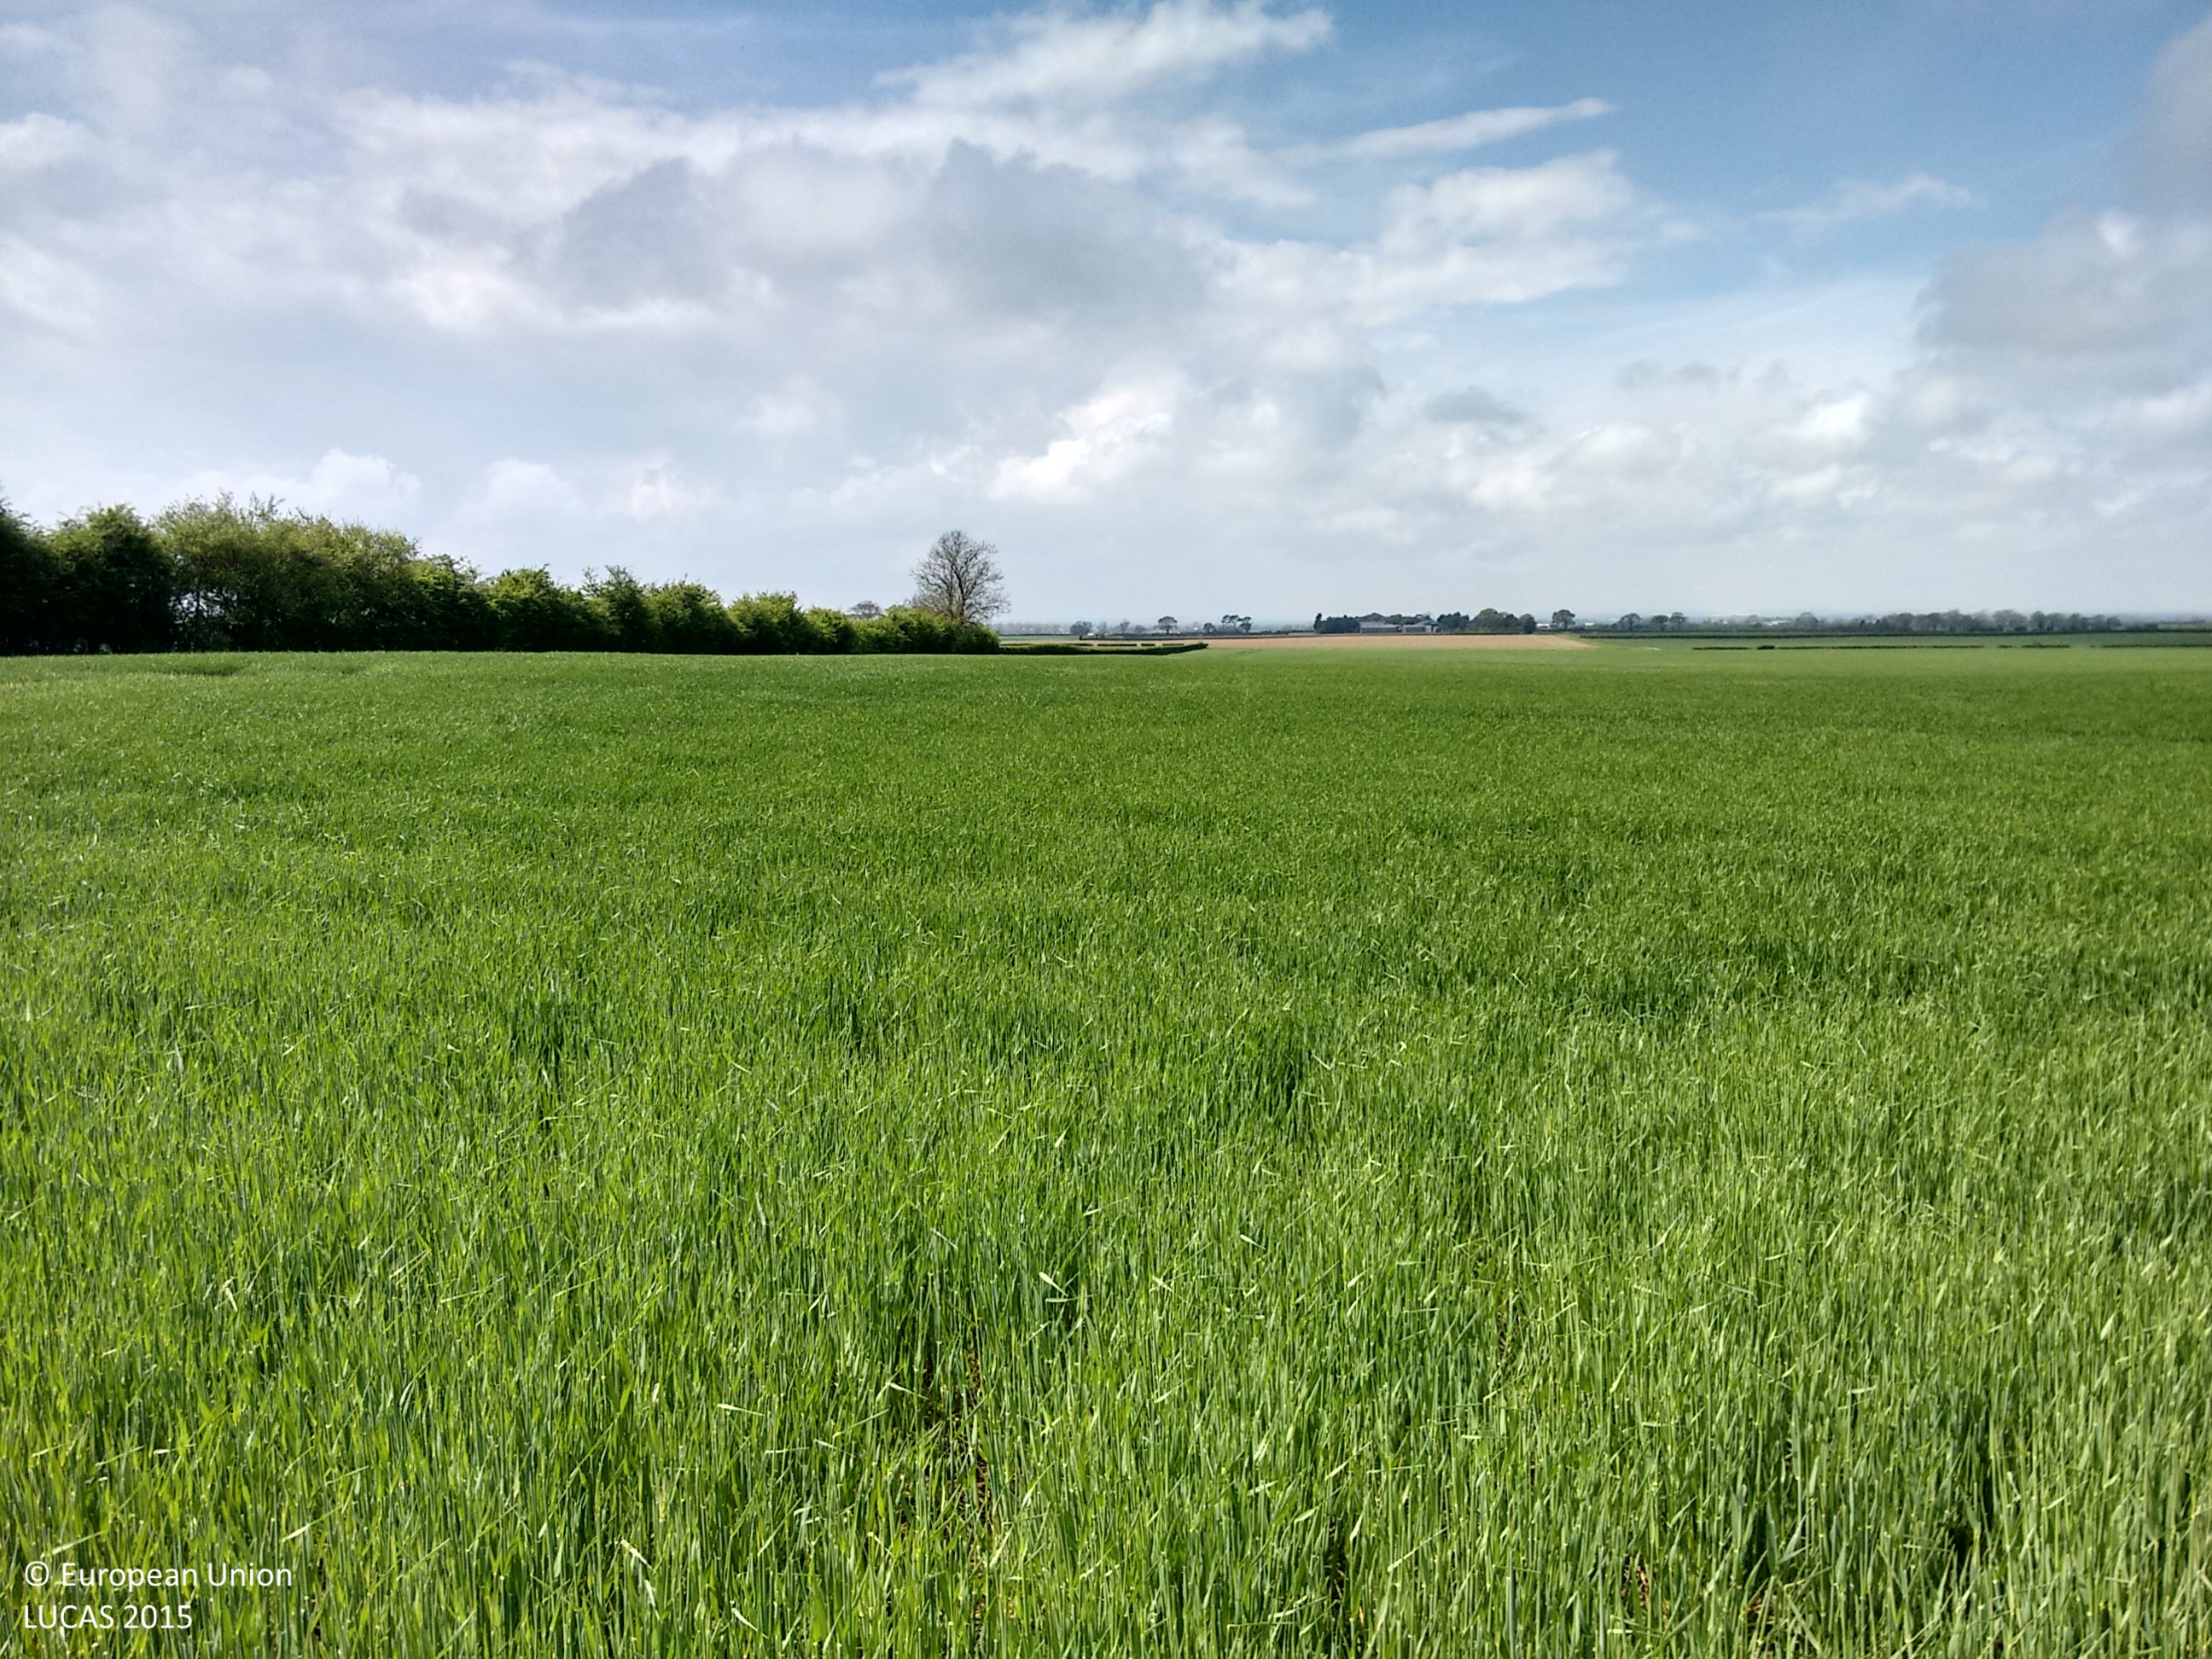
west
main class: Cropland
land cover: Barley
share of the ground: > 75 %
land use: Agriculture (excluding fallow land and kitchen gardens)
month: May
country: GB
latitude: 53.9417
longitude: -0.2869
